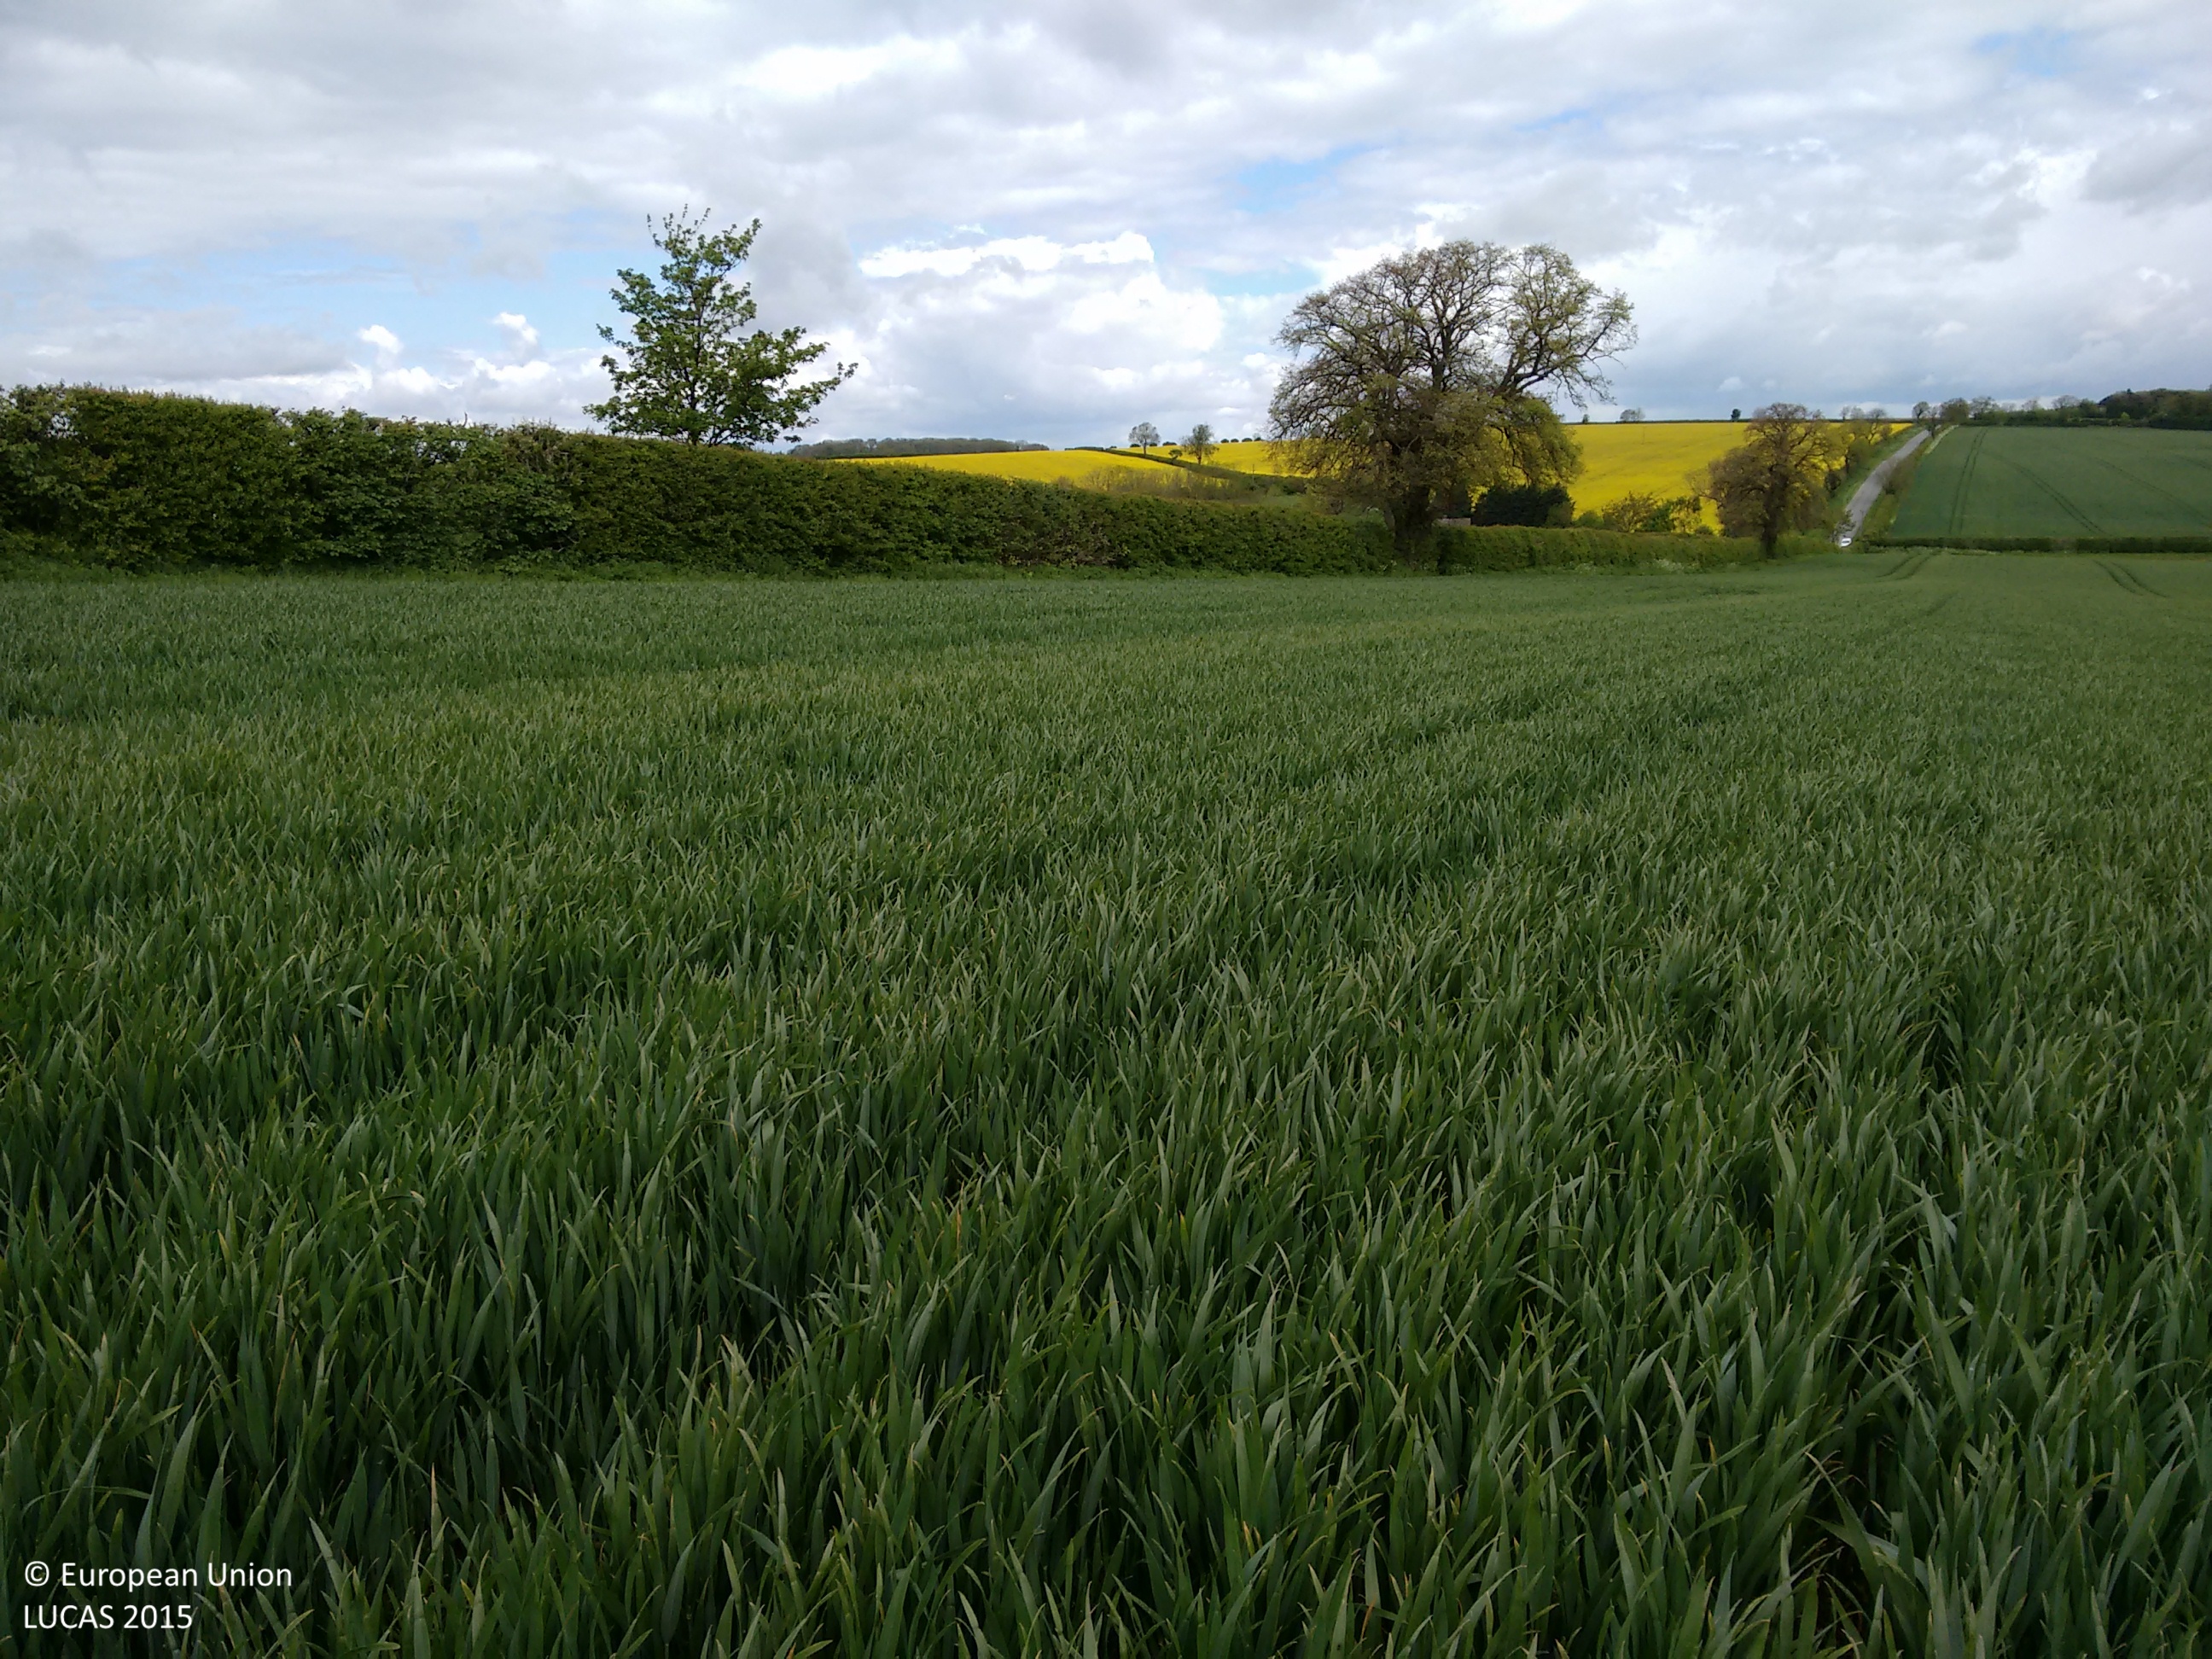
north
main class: Cropland
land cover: Common wheat
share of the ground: > 75 %
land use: Agriculture (excluding fallow land and kitchen gardens)
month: May
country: GB
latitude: 53.4773
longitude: -0.2044
